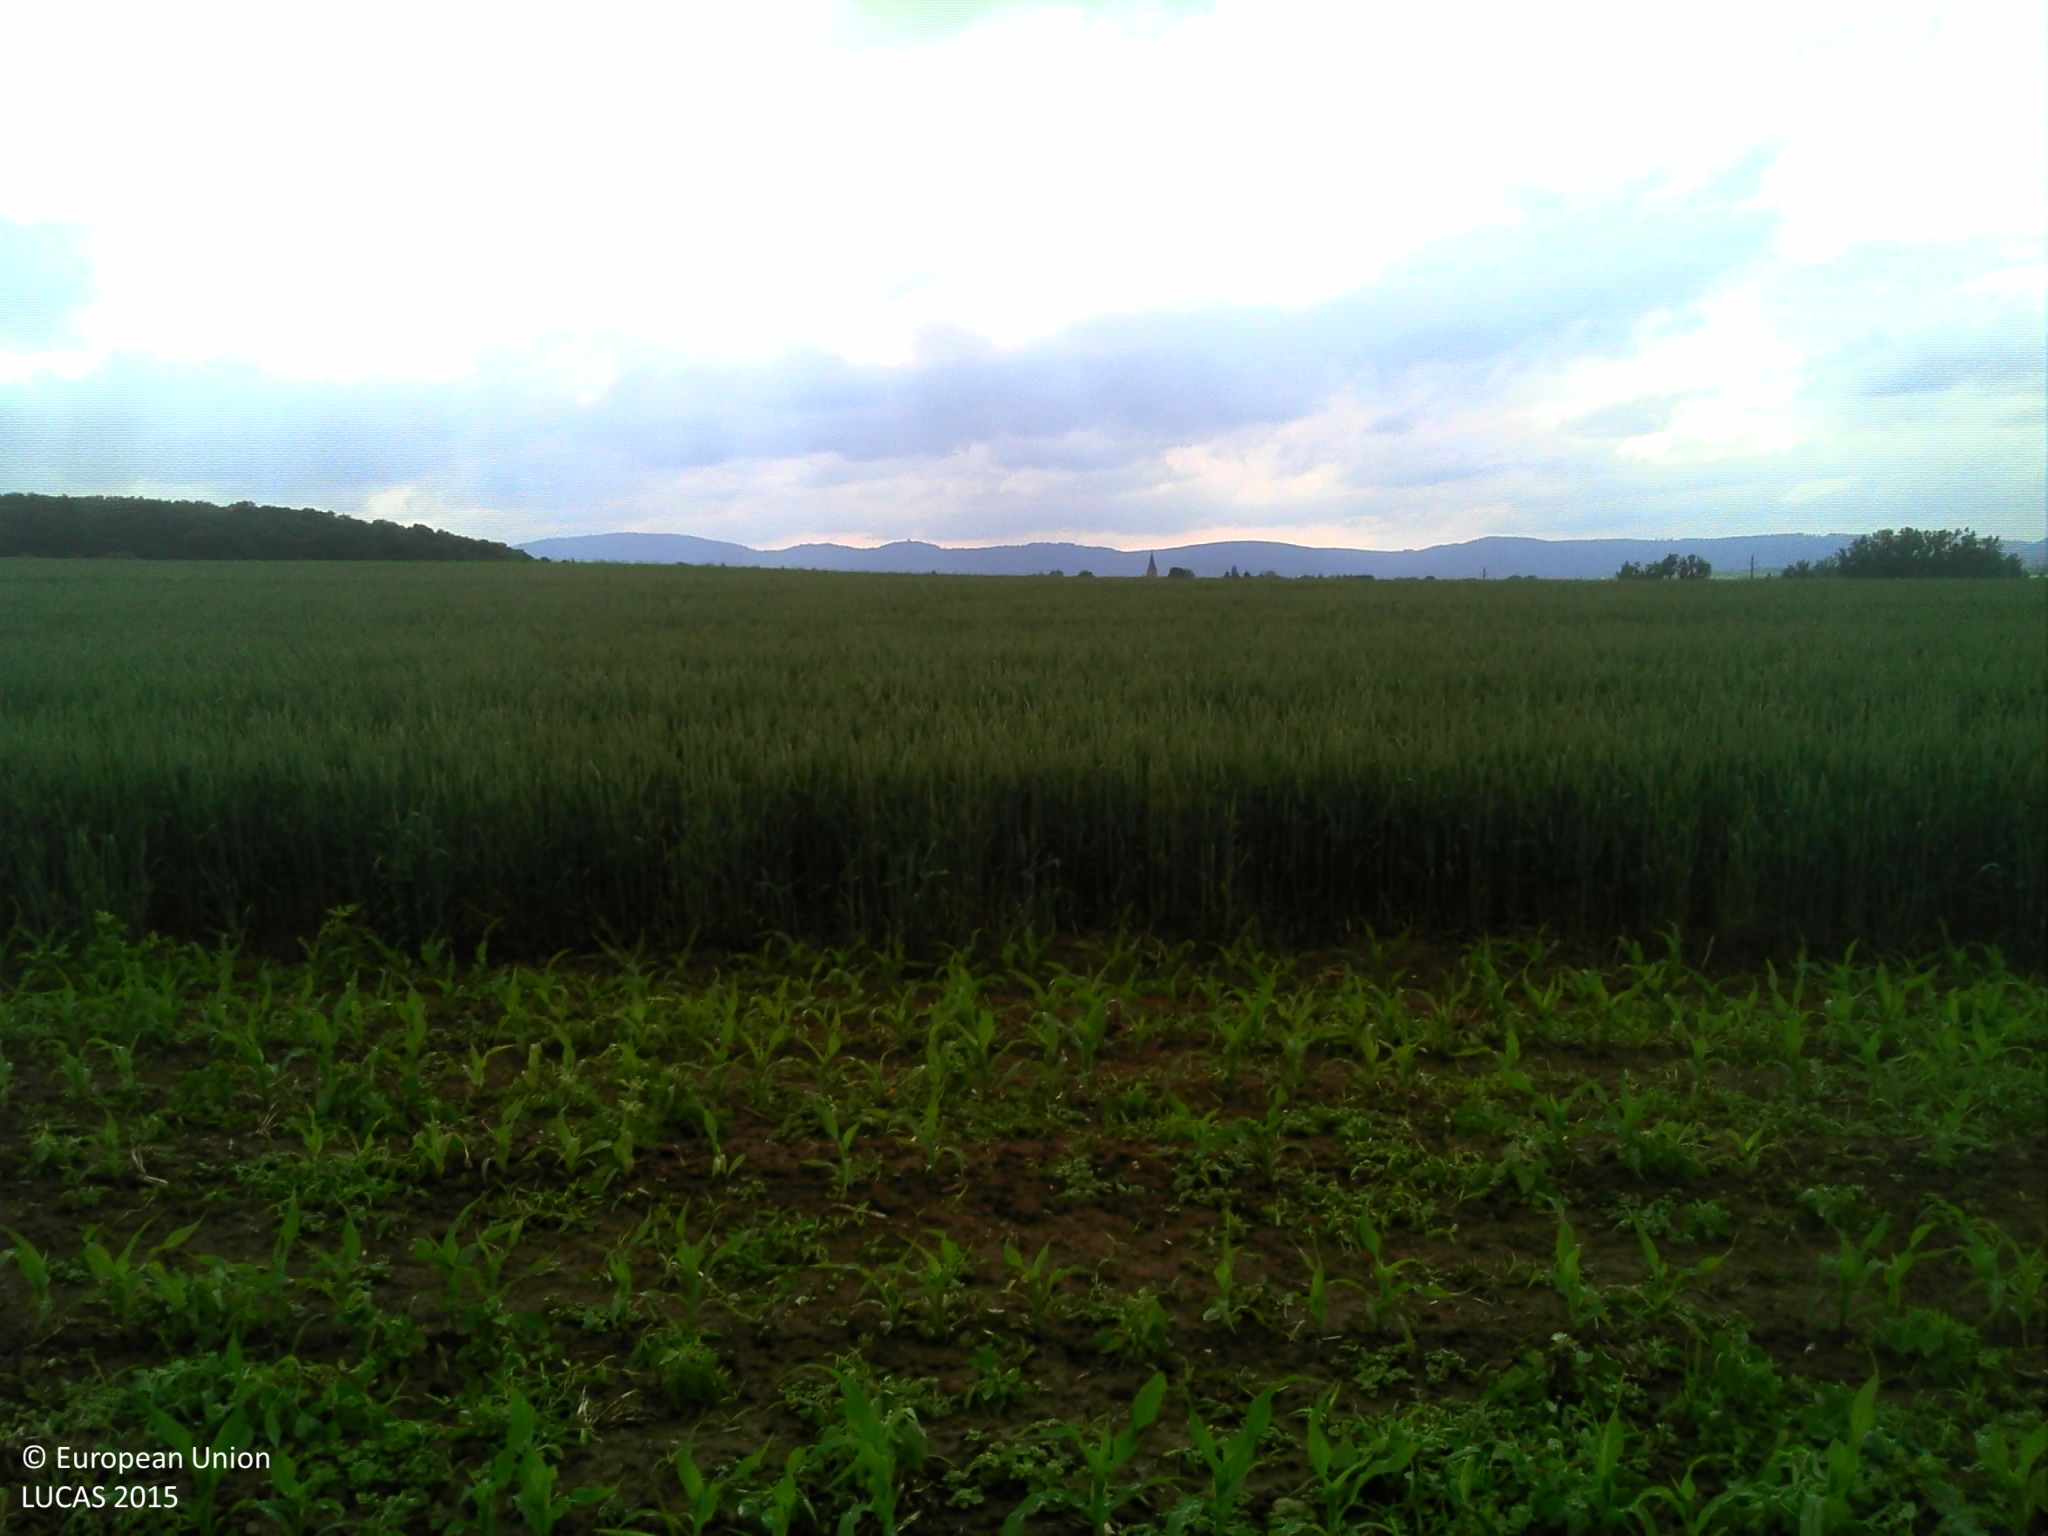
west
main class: Cropland
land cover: Maize
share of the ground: 10 - 25 %
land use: Agriculture (excluding fallow land and kitchen gardens)
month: May
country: FR
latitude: 48.7163
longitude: 7.4591
